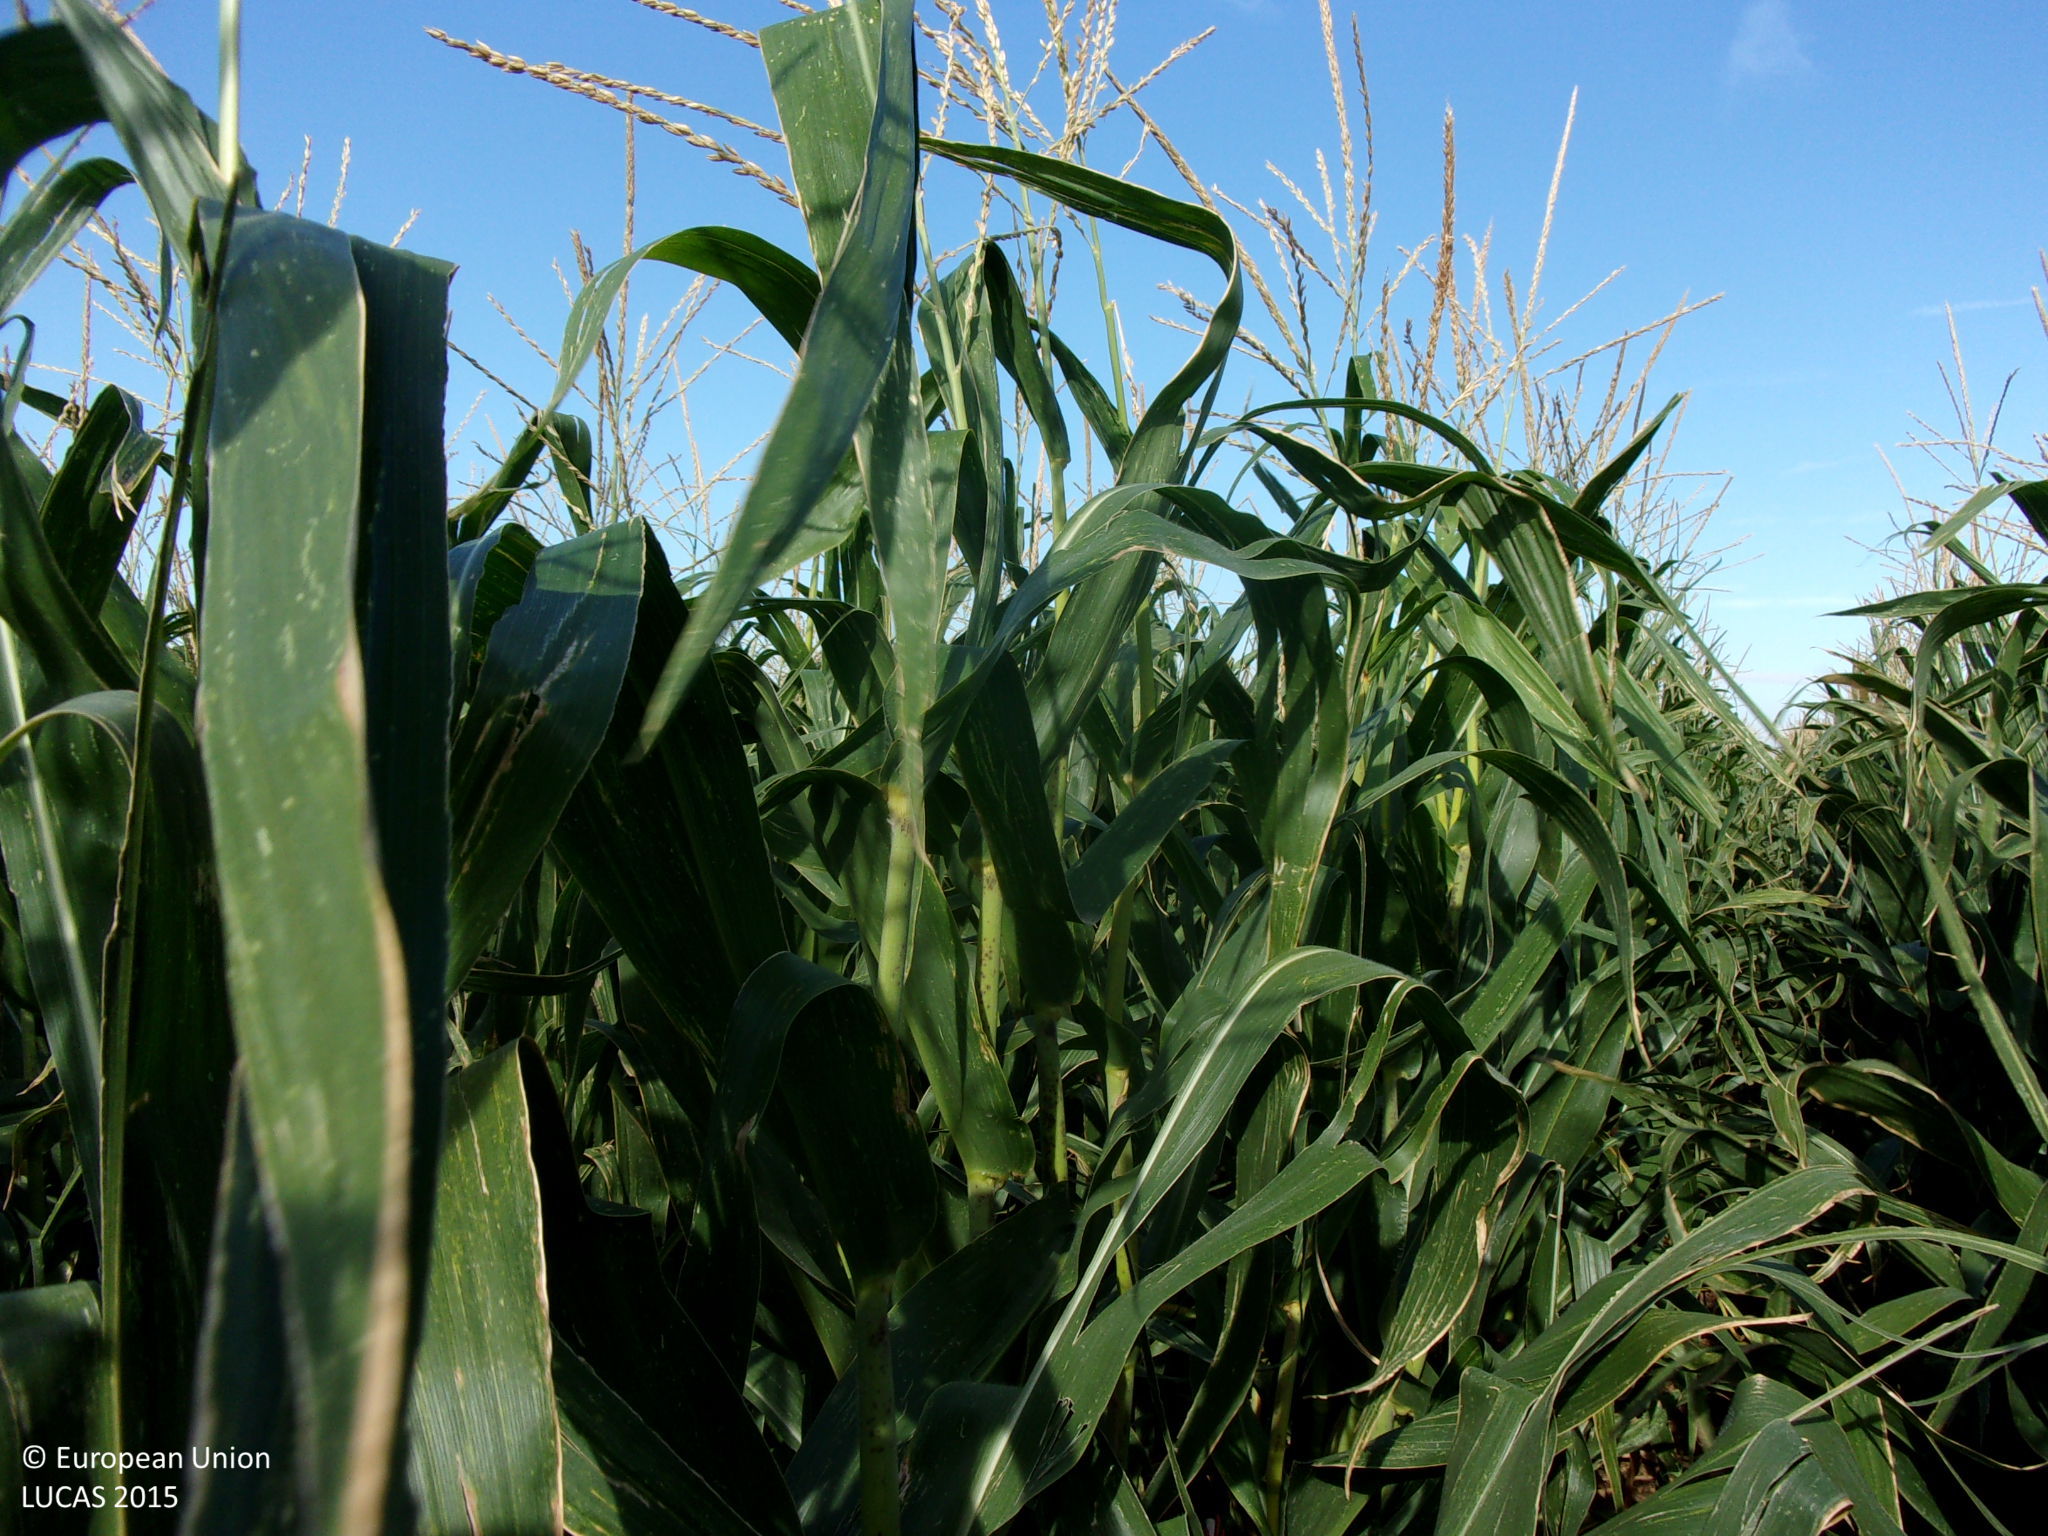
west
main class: Cropland
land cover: Maize
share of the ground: > 75 %
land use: Agriculture (excluding fallow land and kitchen gardens)
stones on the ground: 10 - 25 %
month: August
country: ES
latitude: 42.0593
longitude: -1.1084
